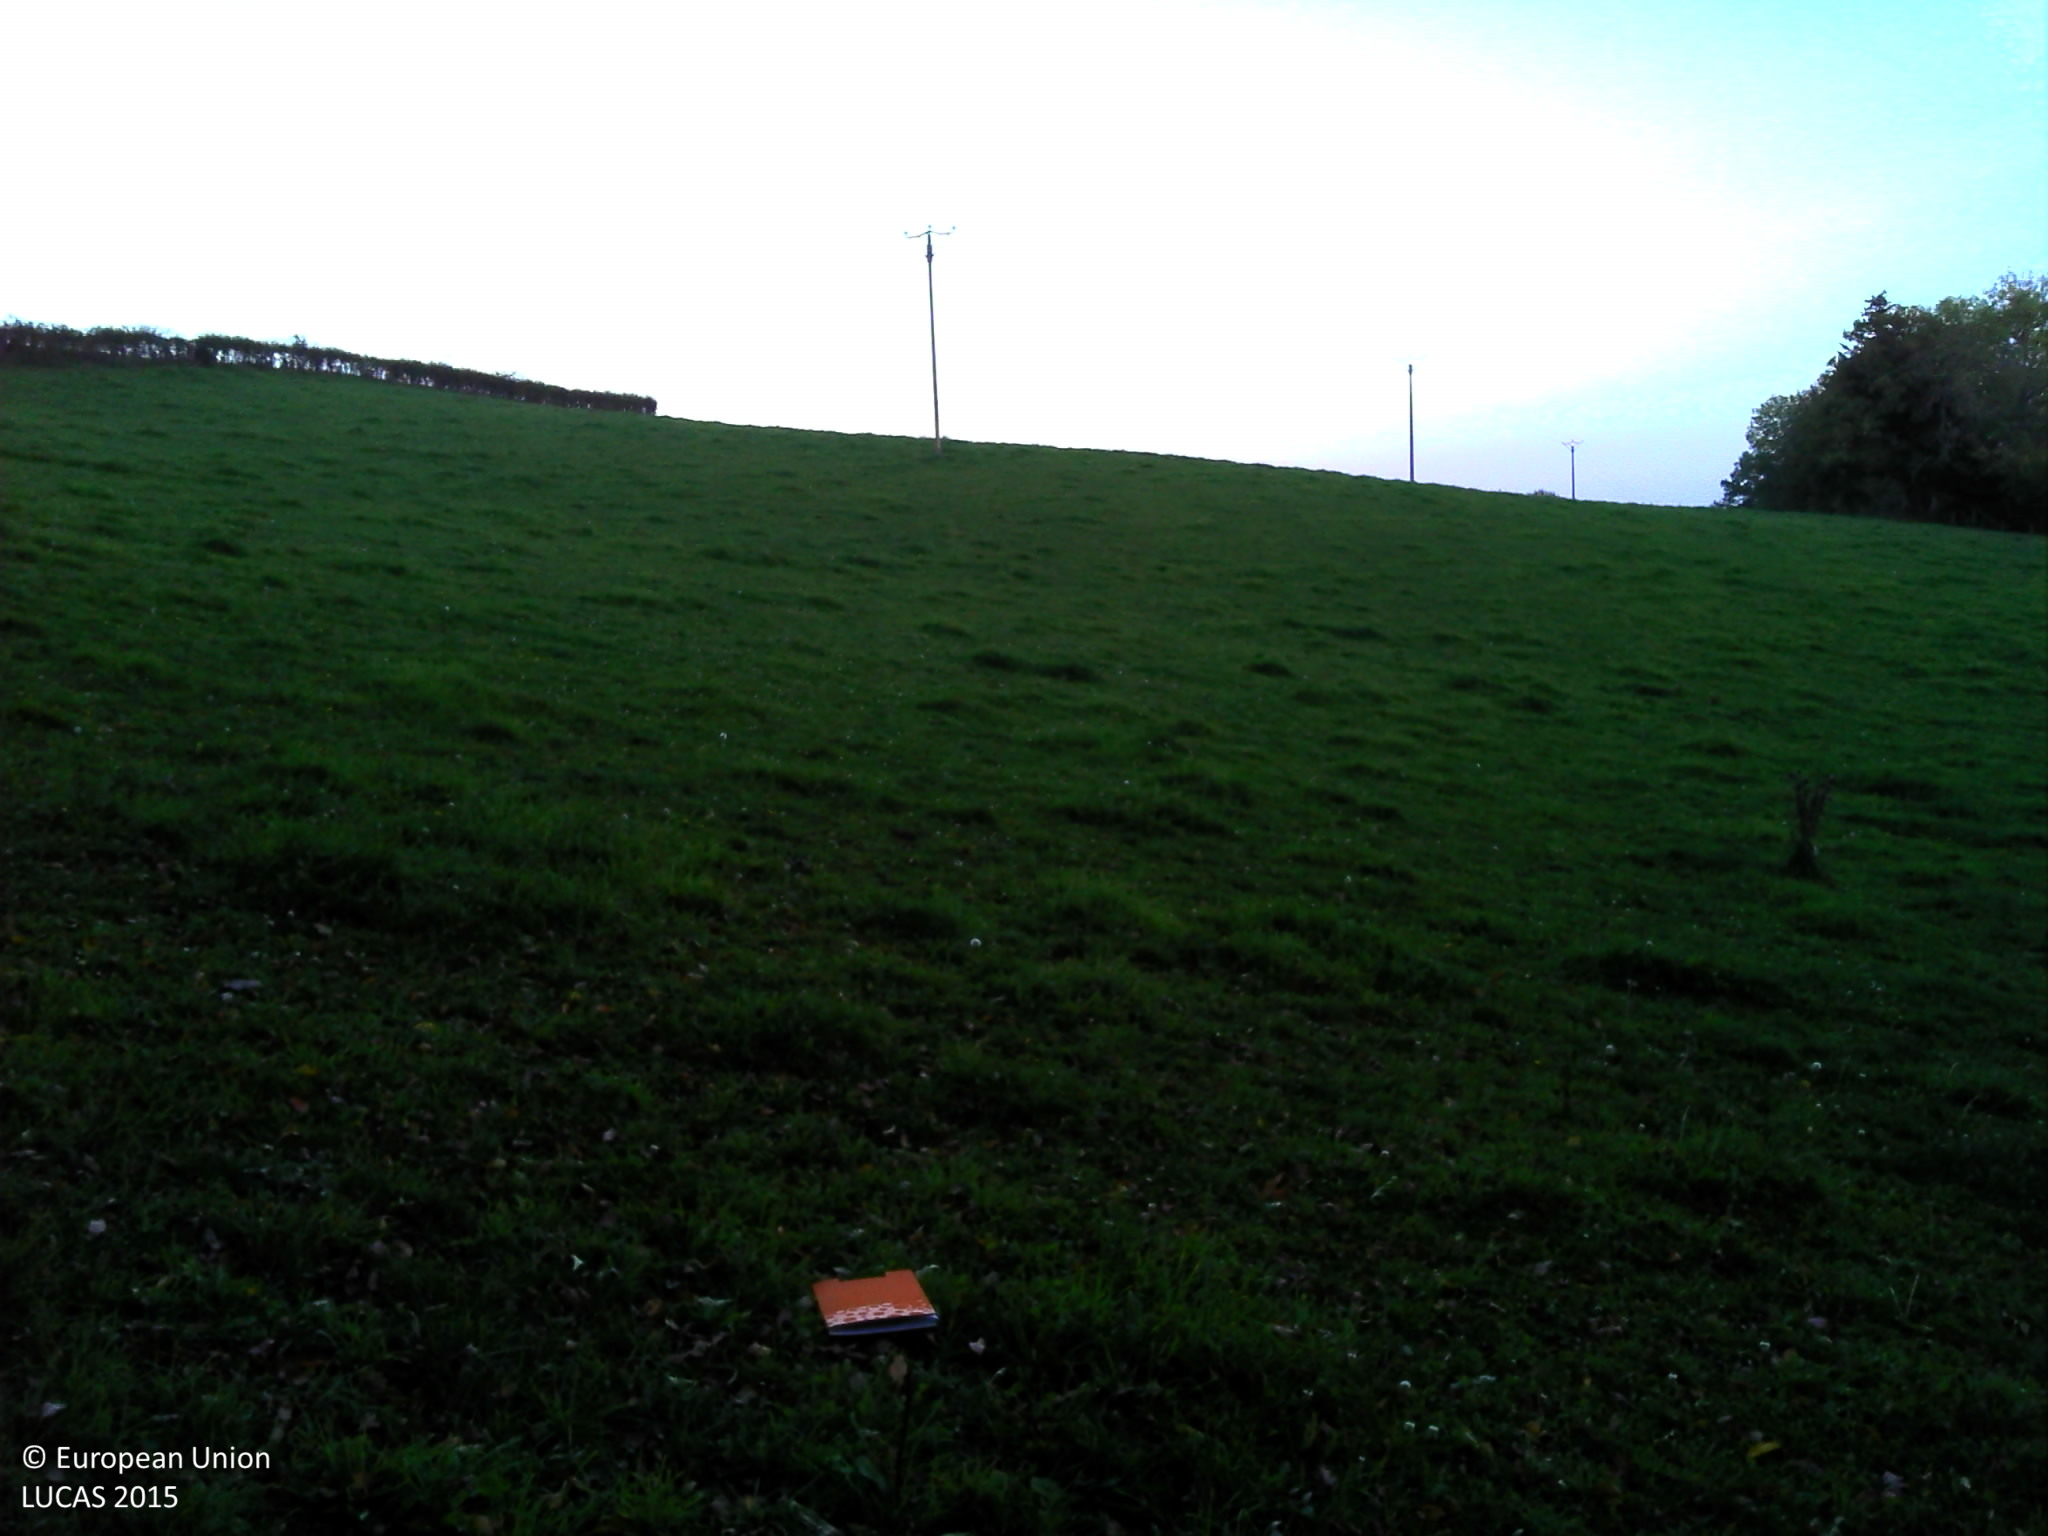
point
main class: Grassland
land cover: Grassland without tree/shrub cover
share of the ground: > 75 %
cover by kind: herbaceous plants 100 %
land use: Agriculture (excluding fallow land and kitchen gardens)
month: October
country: FR
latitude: 46.0703
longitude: 2.7704
